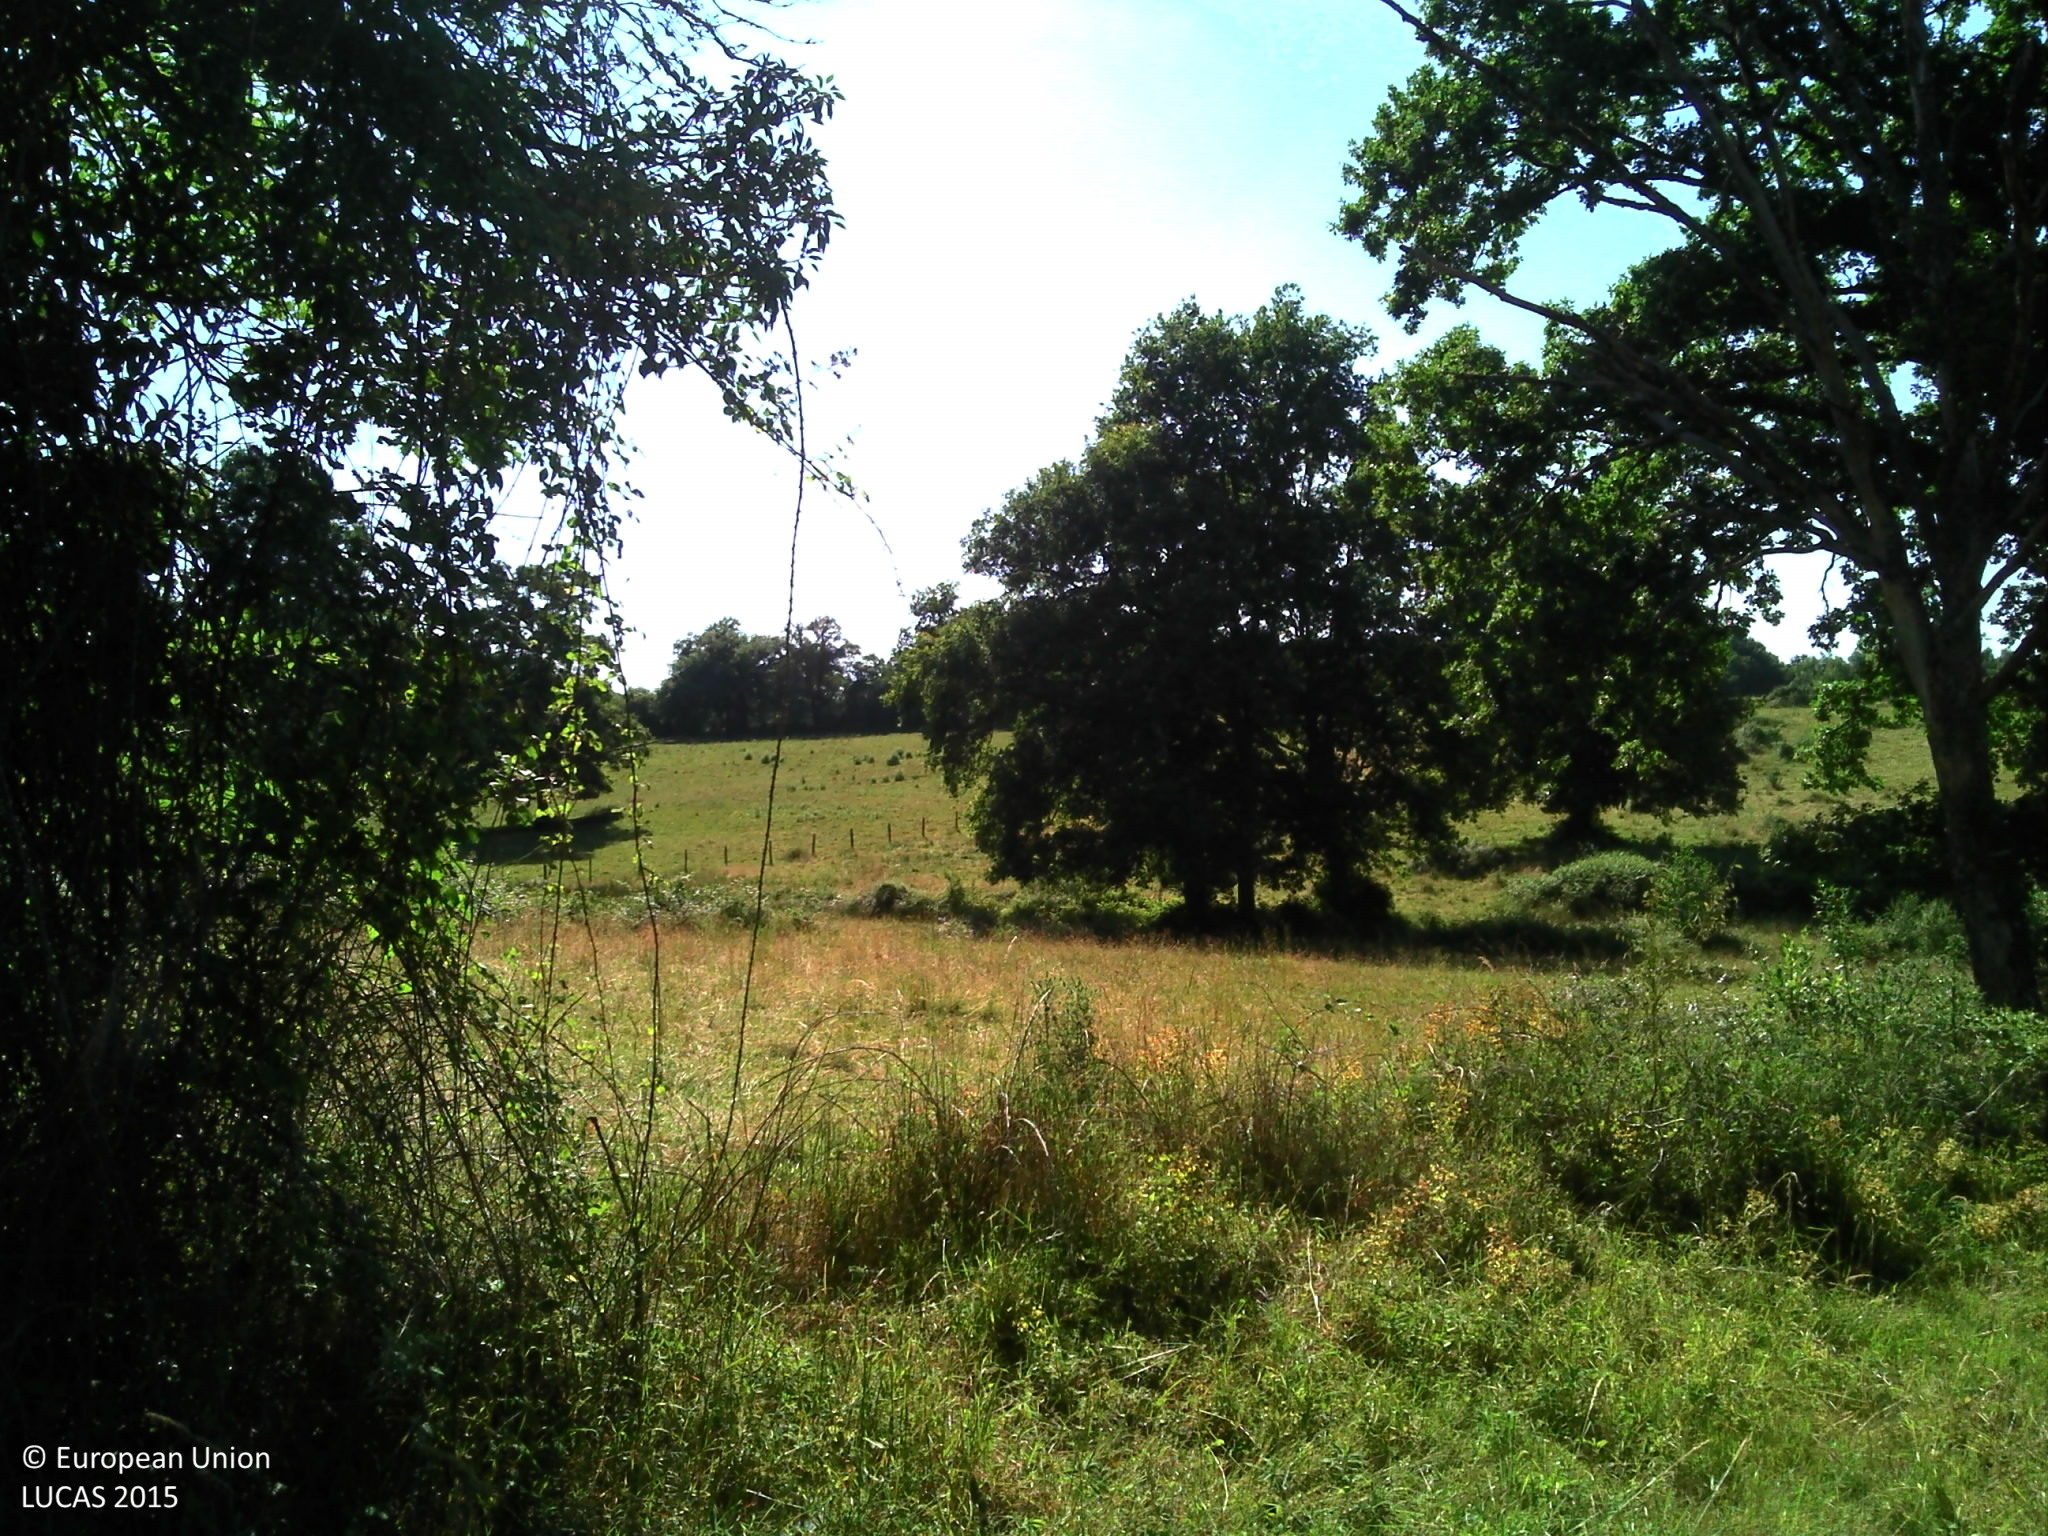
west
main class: Grassland
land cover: Grassland with sparse tree/shrub cover
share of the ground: > 75 %
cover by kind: herbaceous plants 95 %, broadleaved forest trees 5 %
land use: Agriculture (excluding fallow land and kitchen gardens)
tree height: > 5 m
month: June
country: FR
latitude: 45.8168
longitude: 0.6819
